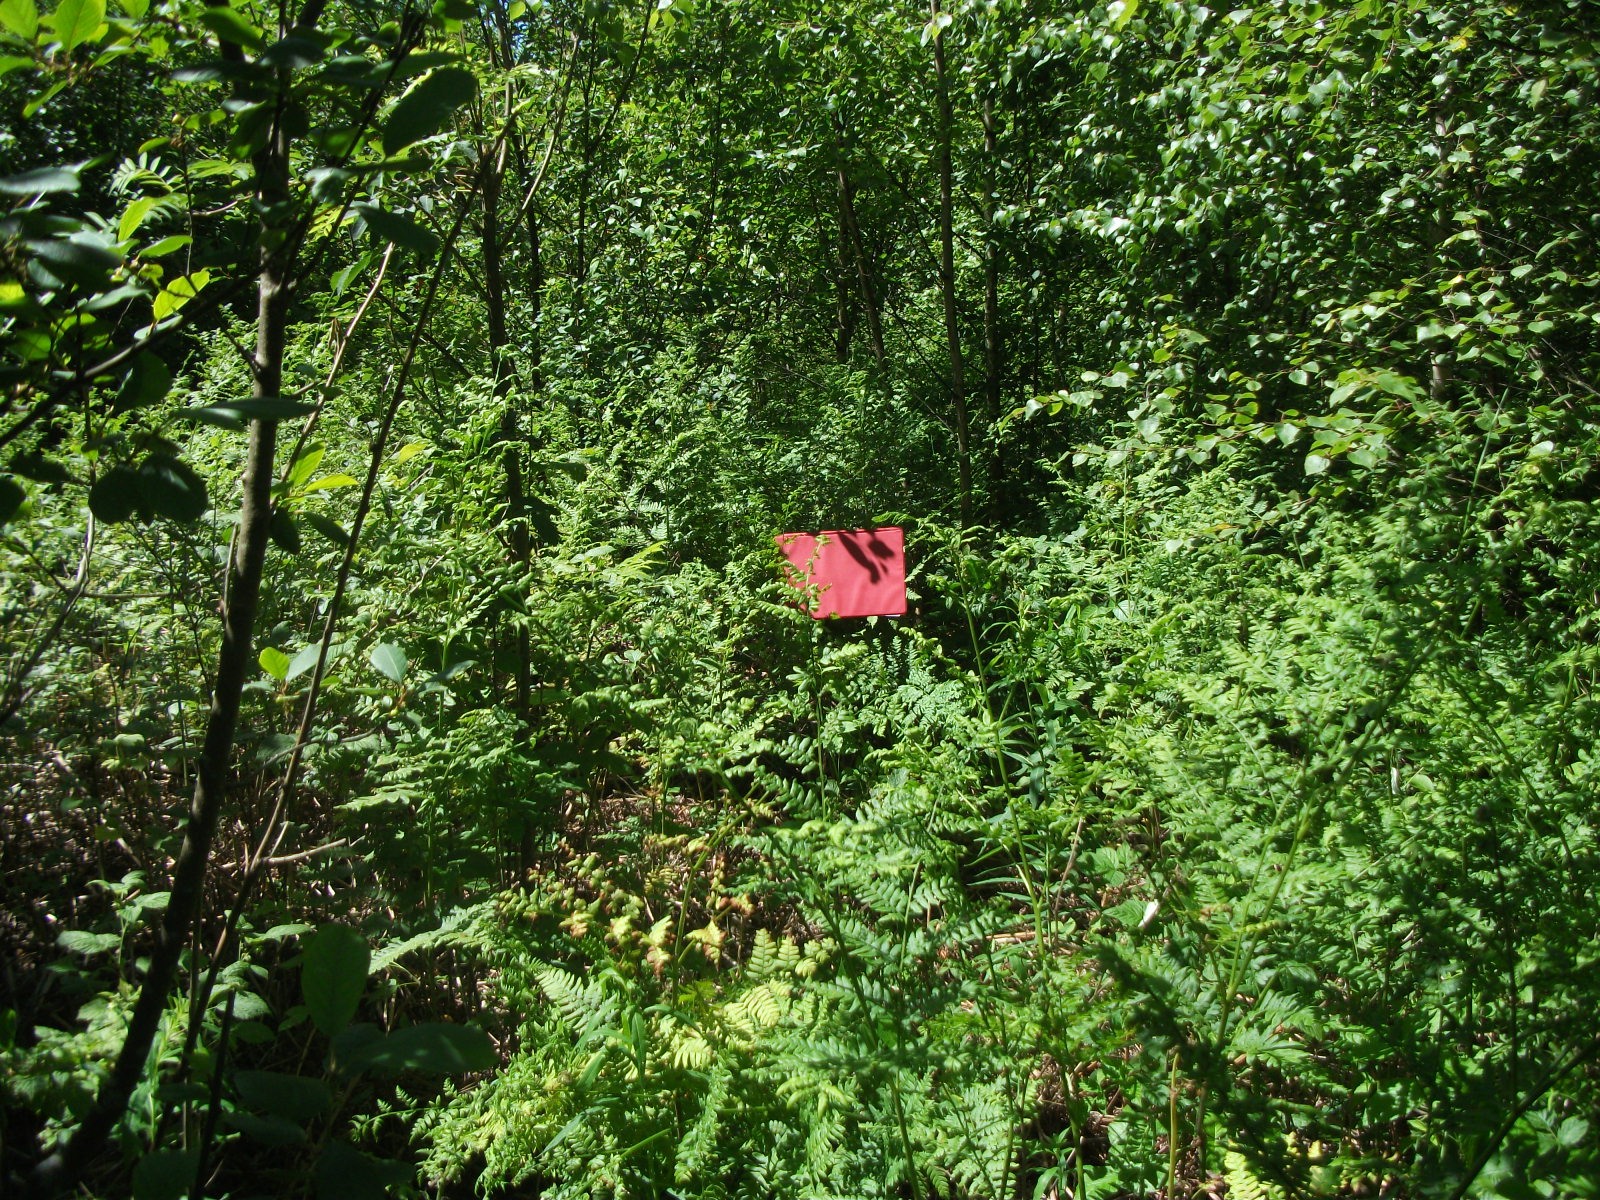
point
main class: Woodland
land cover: Broadleaved woodland
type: non-riverine alder, birch or aspen forest
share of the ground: > 75 %
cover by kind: broadleaved forest trees 90 %, shrubs 5 %, herbaceous plants 5 %
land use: Forestry
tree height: < 5 m
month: July
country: LV
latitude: 56.8028
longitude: 26.2028
